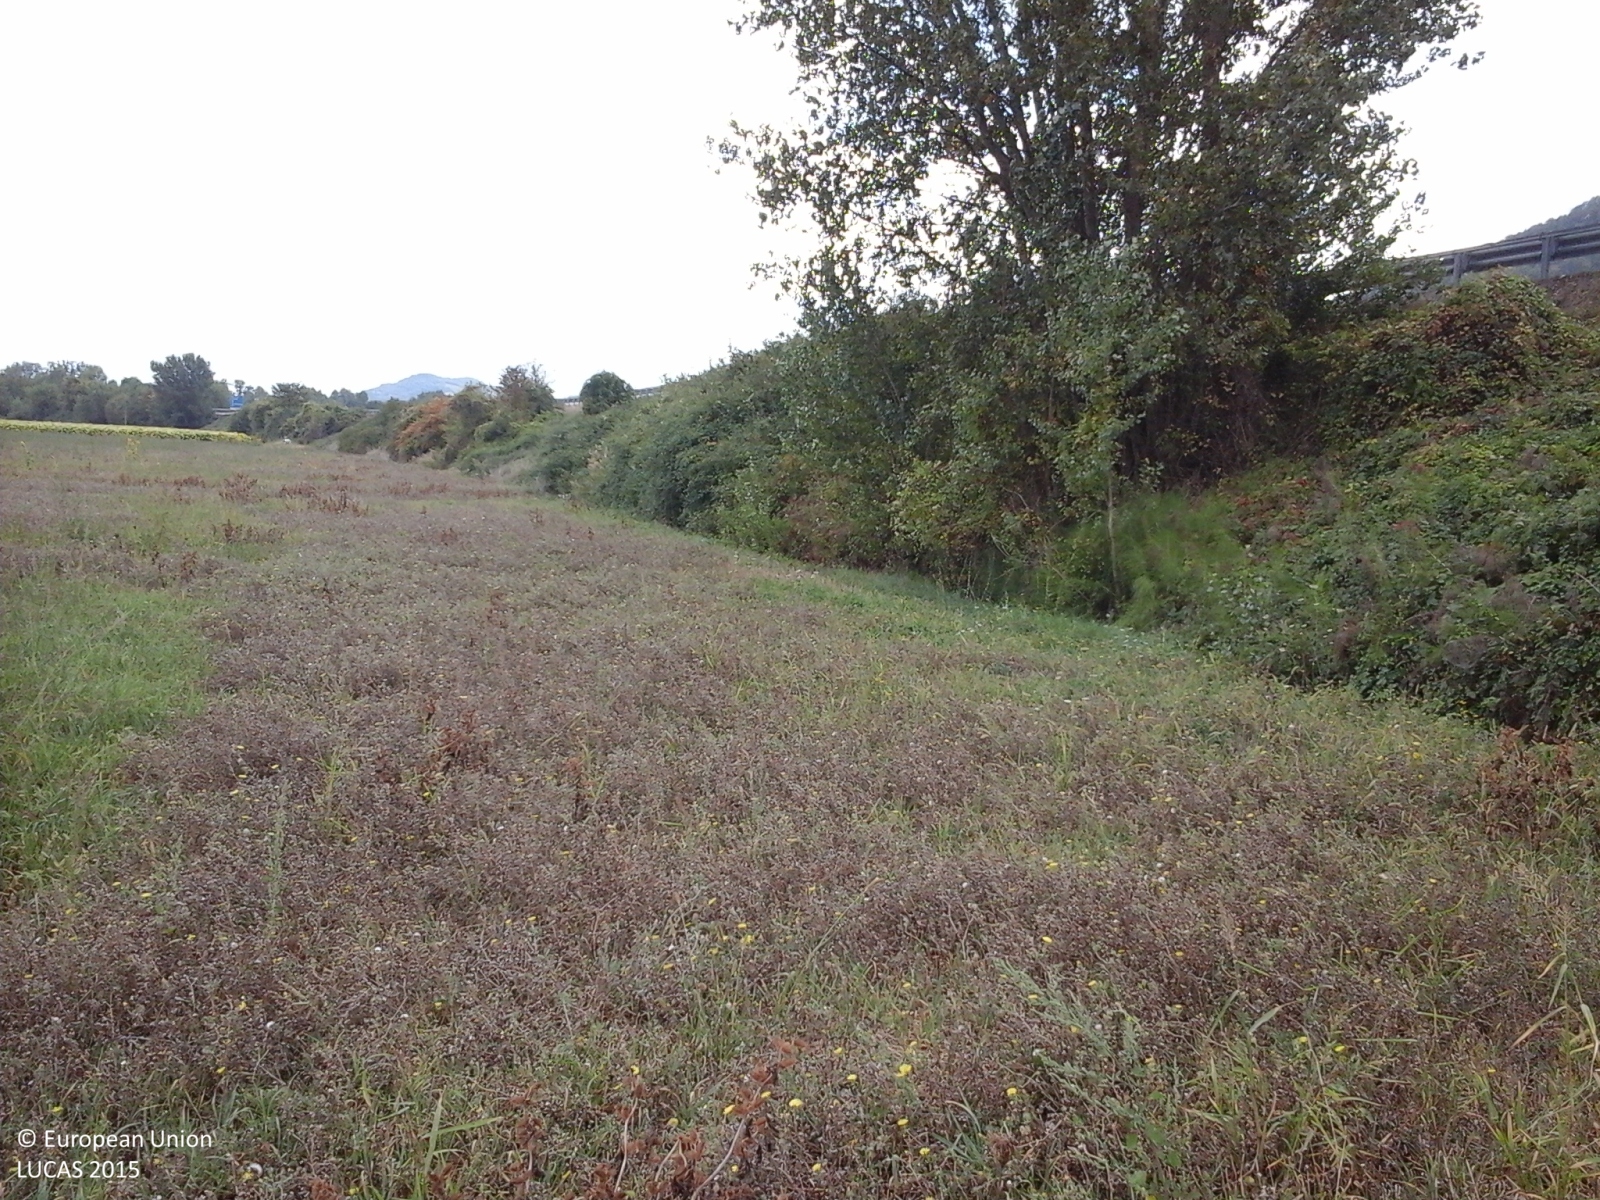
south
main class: Grassland
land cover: Spontaneously vegetated surfaces
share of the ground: 50 - 75 %
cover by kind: herbaceous plants 100 %
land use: Fallow land
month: October
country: IT
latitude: 43.2032
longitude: 12.4177
